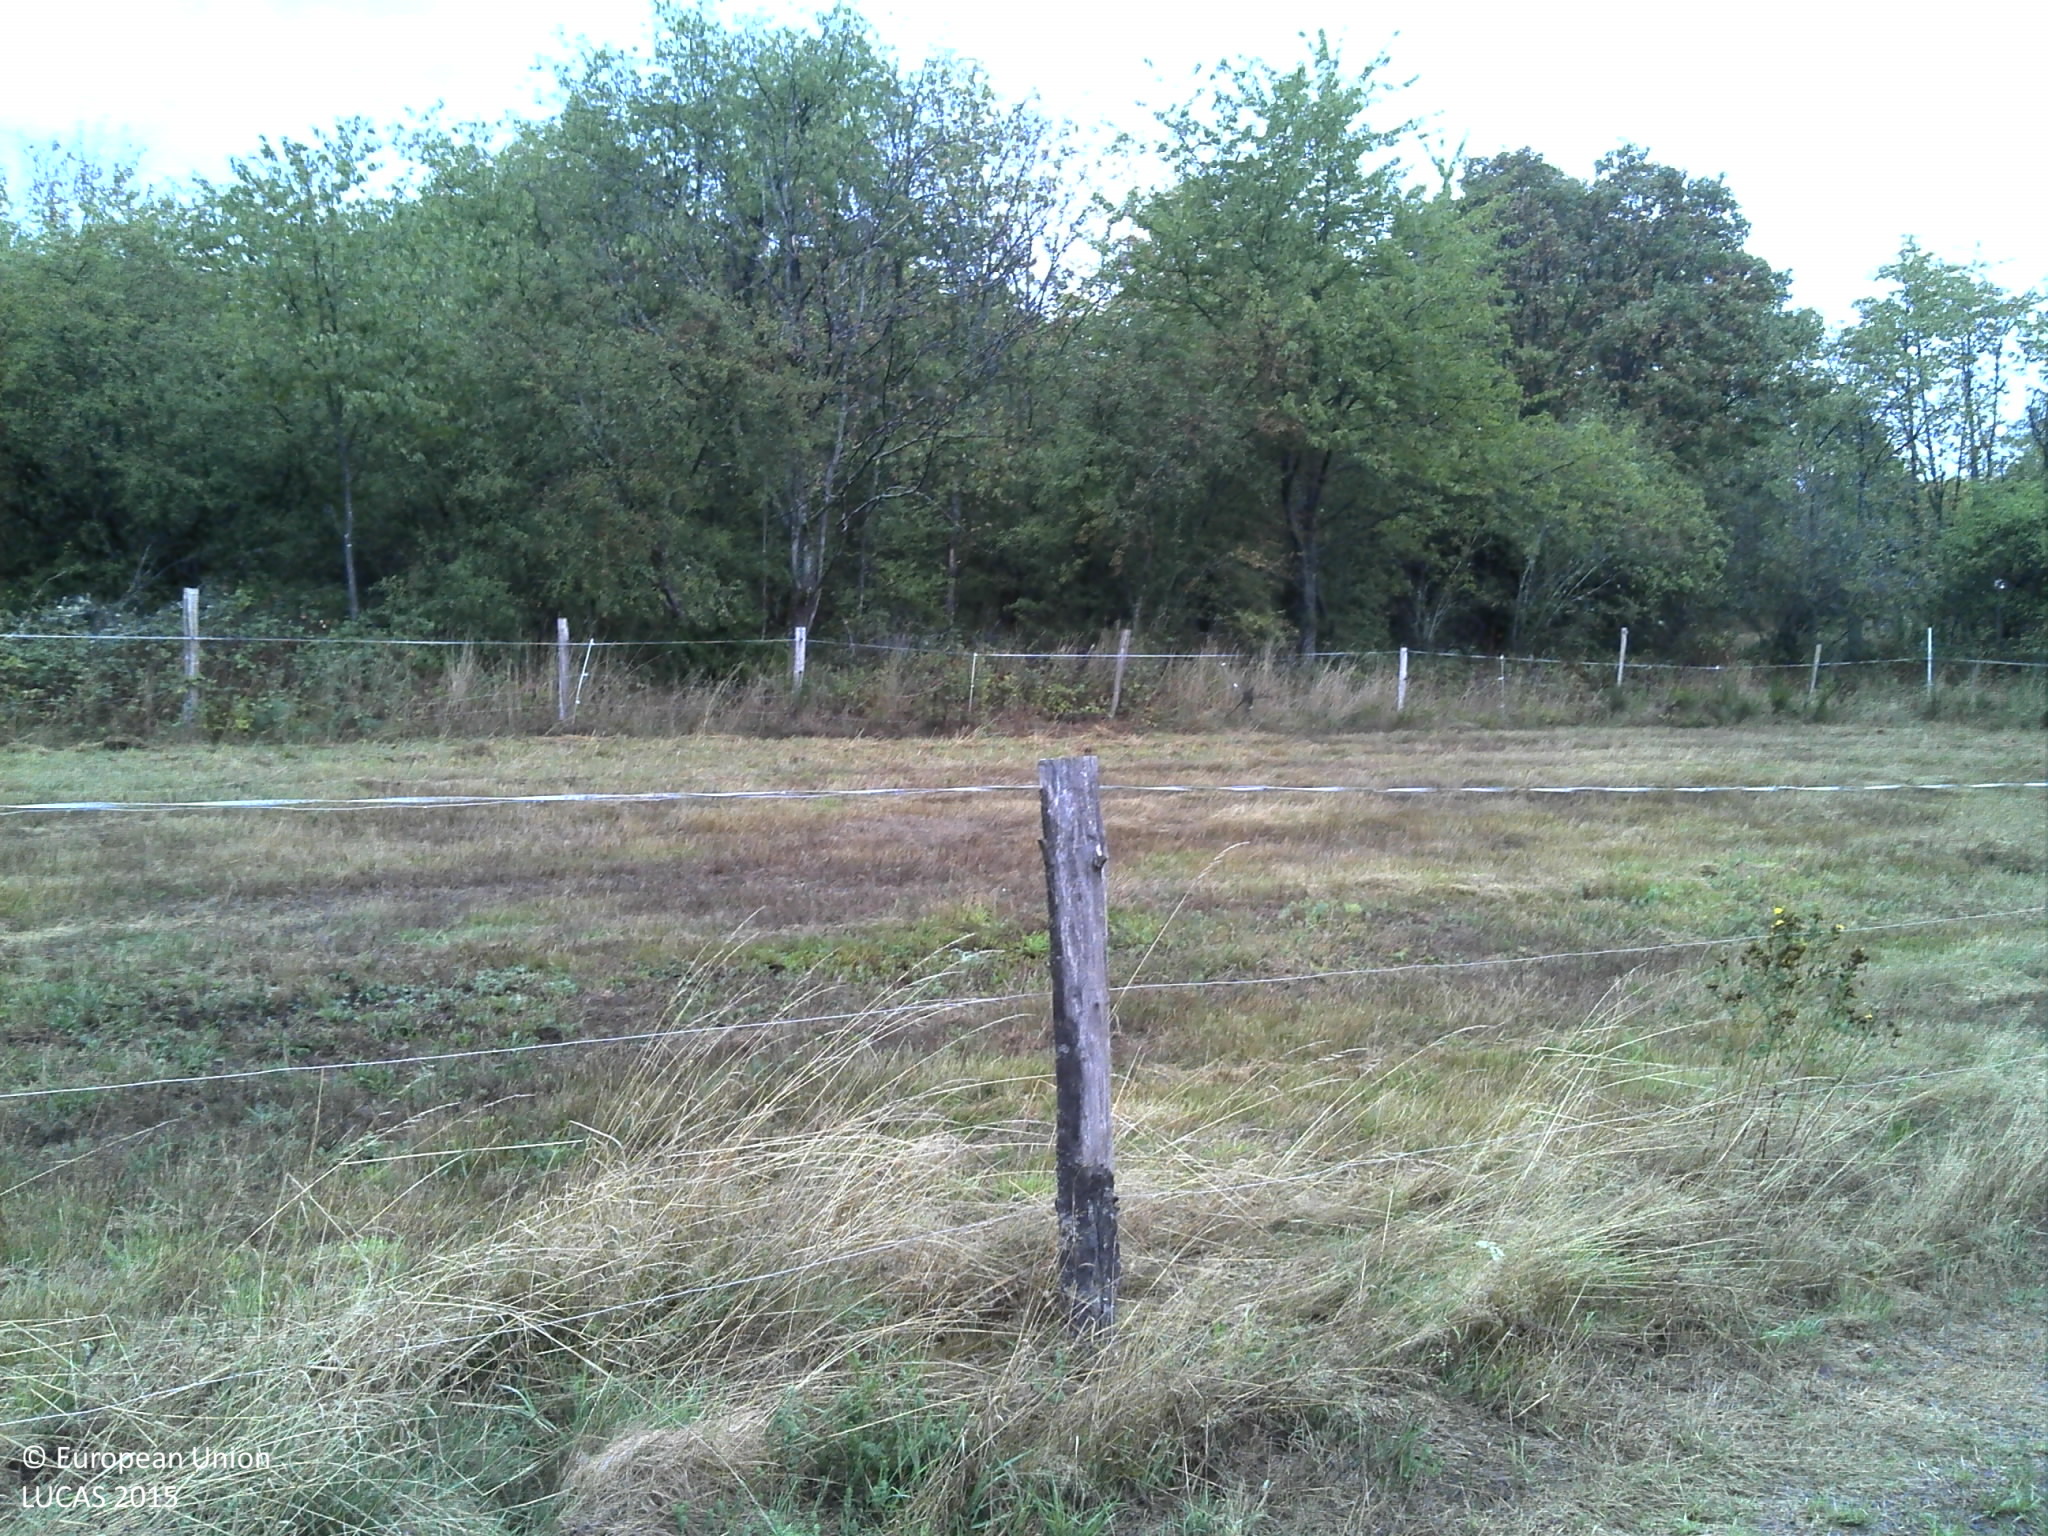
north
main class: Grassland
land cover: Grassland without tree/shrub cover
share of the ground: > 75 %
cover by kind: herbaceous plants 100 %
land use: Agriculture (excluding fallow land and kitchen gardens)
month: September
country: FR
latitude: 48.5141
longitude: 7.2798
